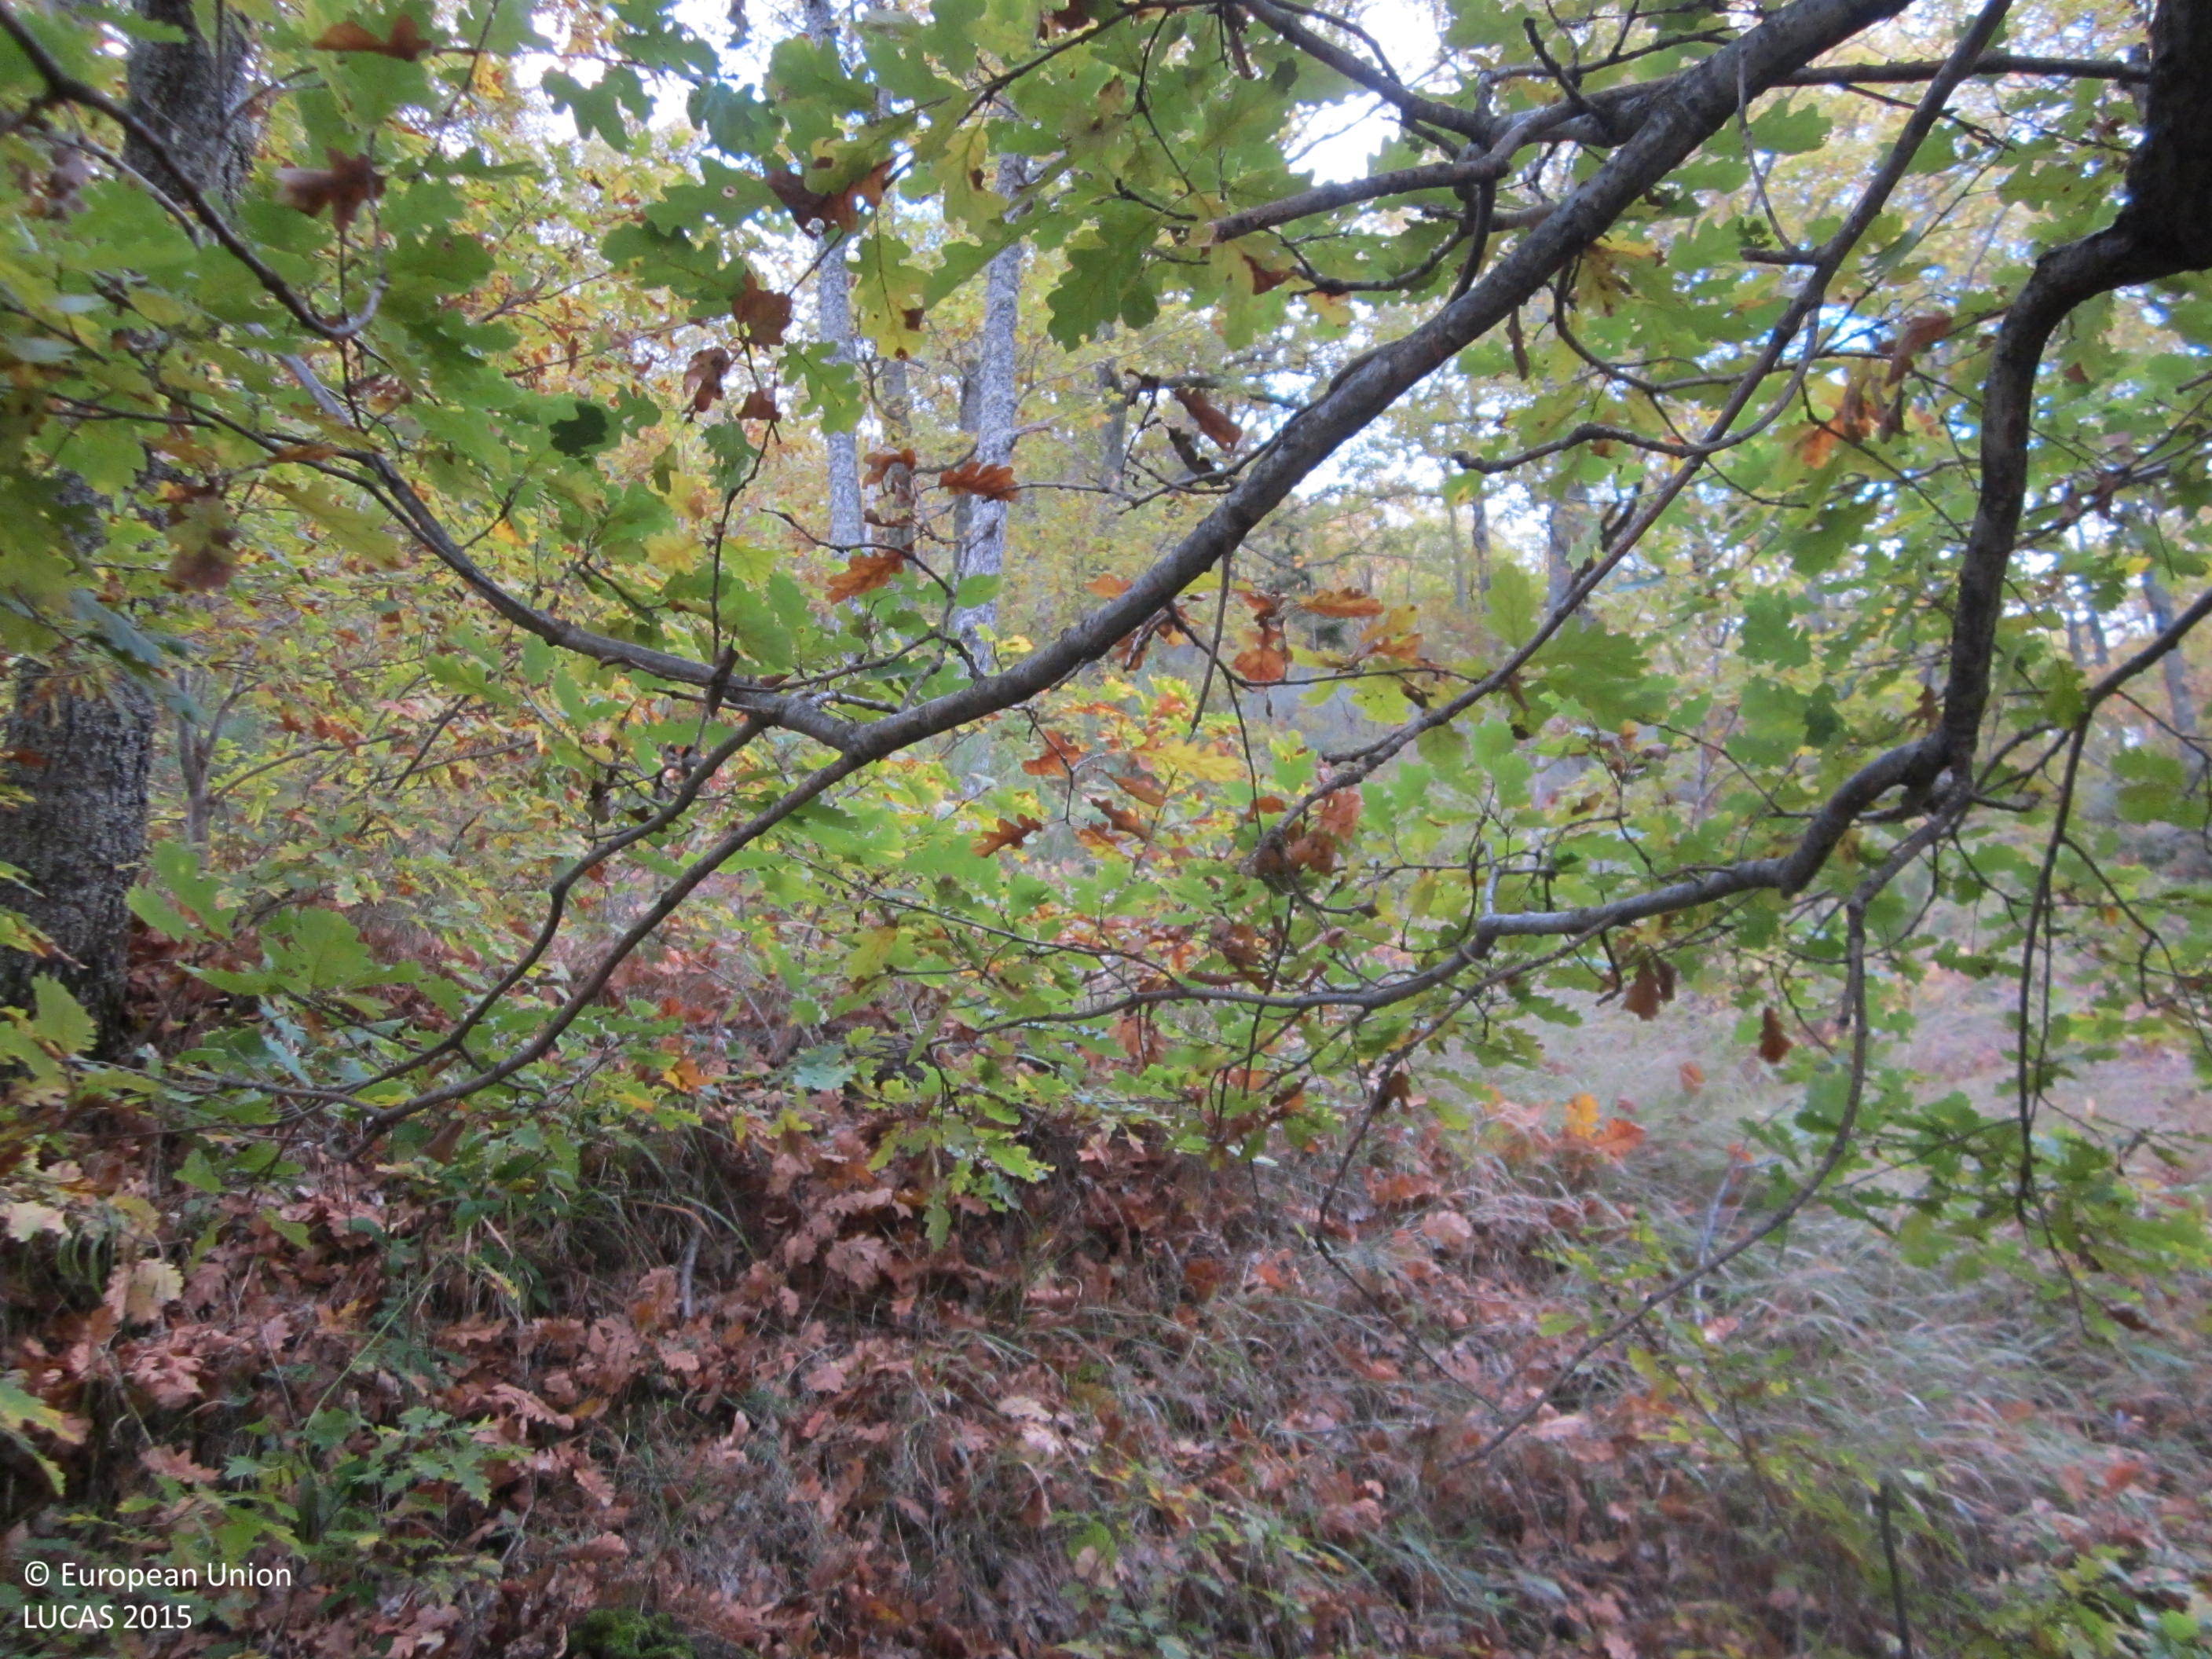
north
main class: Woodland
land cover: Broadleaved woodland
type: acidophilous oak and oak-birch forest
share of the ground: > 75 %
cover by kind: broadleaved forest trees 90 %, shrubs 5 %, herbaceous plants 5 %
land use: Forestry
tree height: > 5 m
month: November
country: BG
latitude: 41.3632
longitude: 25.8301
